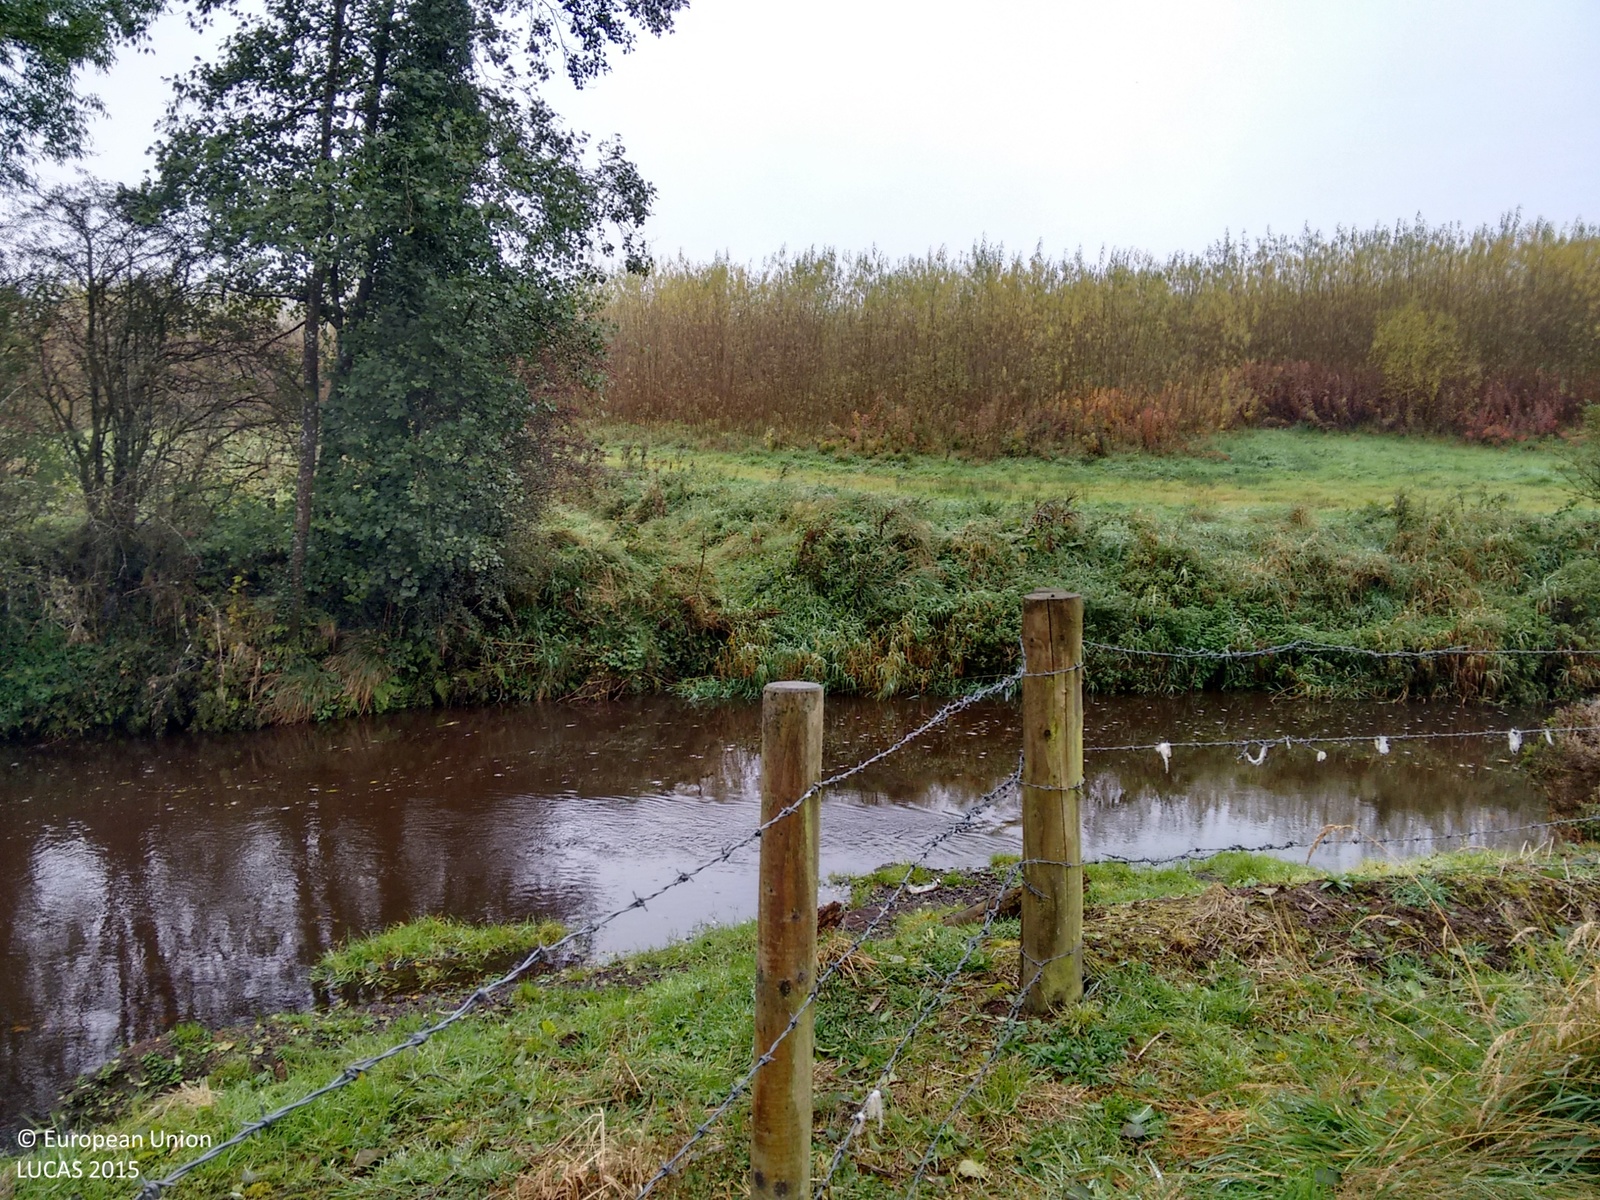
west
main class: Grassland
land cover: Grassland without tree/shrub cover
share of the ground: > 75 %
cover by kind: herbaceous plants 100 %
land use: Agriculture (excluding fallow land and kitchen gardens)
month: October
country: GB
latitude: 54.5351
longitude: -7.4477
